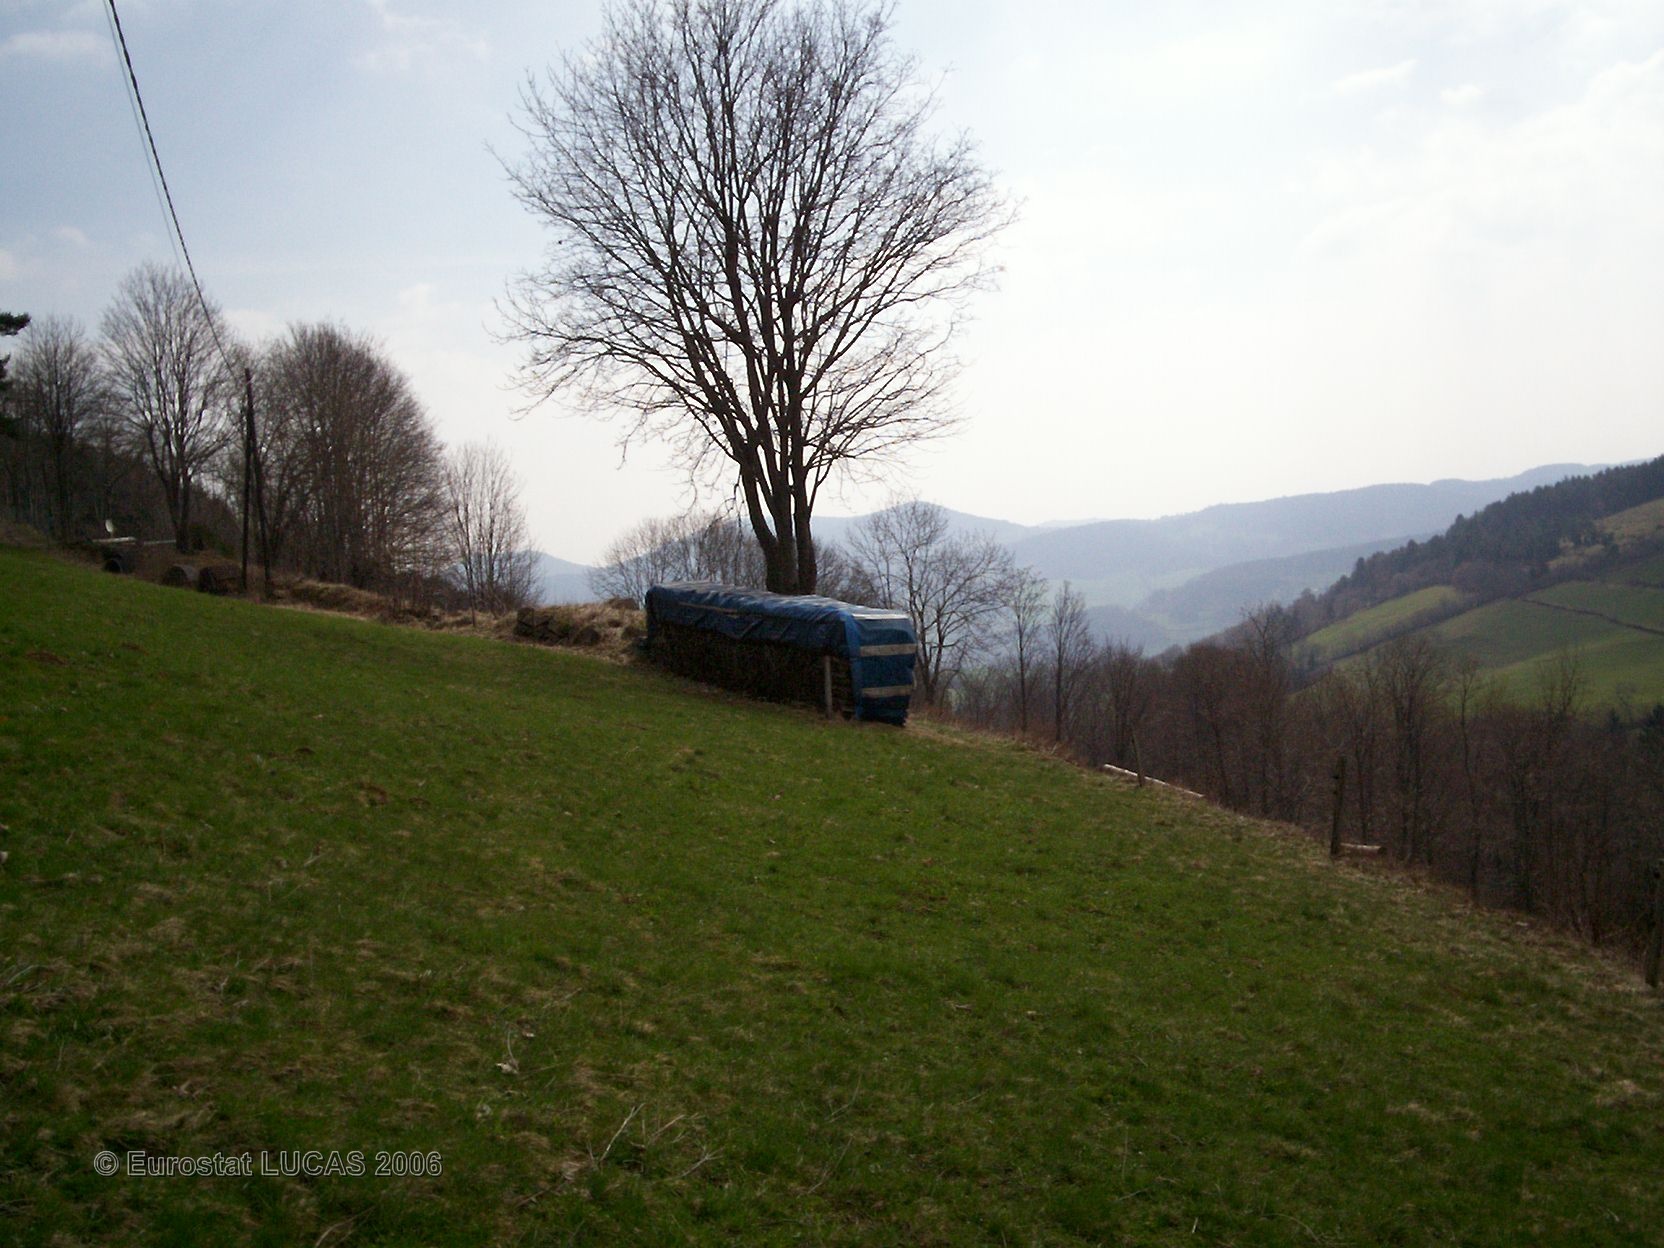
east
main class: Grassland
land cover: Grassland without tree/shrub cover
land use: Agriculture (excluding fallow land and kitchen gardens)
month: April
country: FR
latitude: 48.1317
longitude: 7.1122
